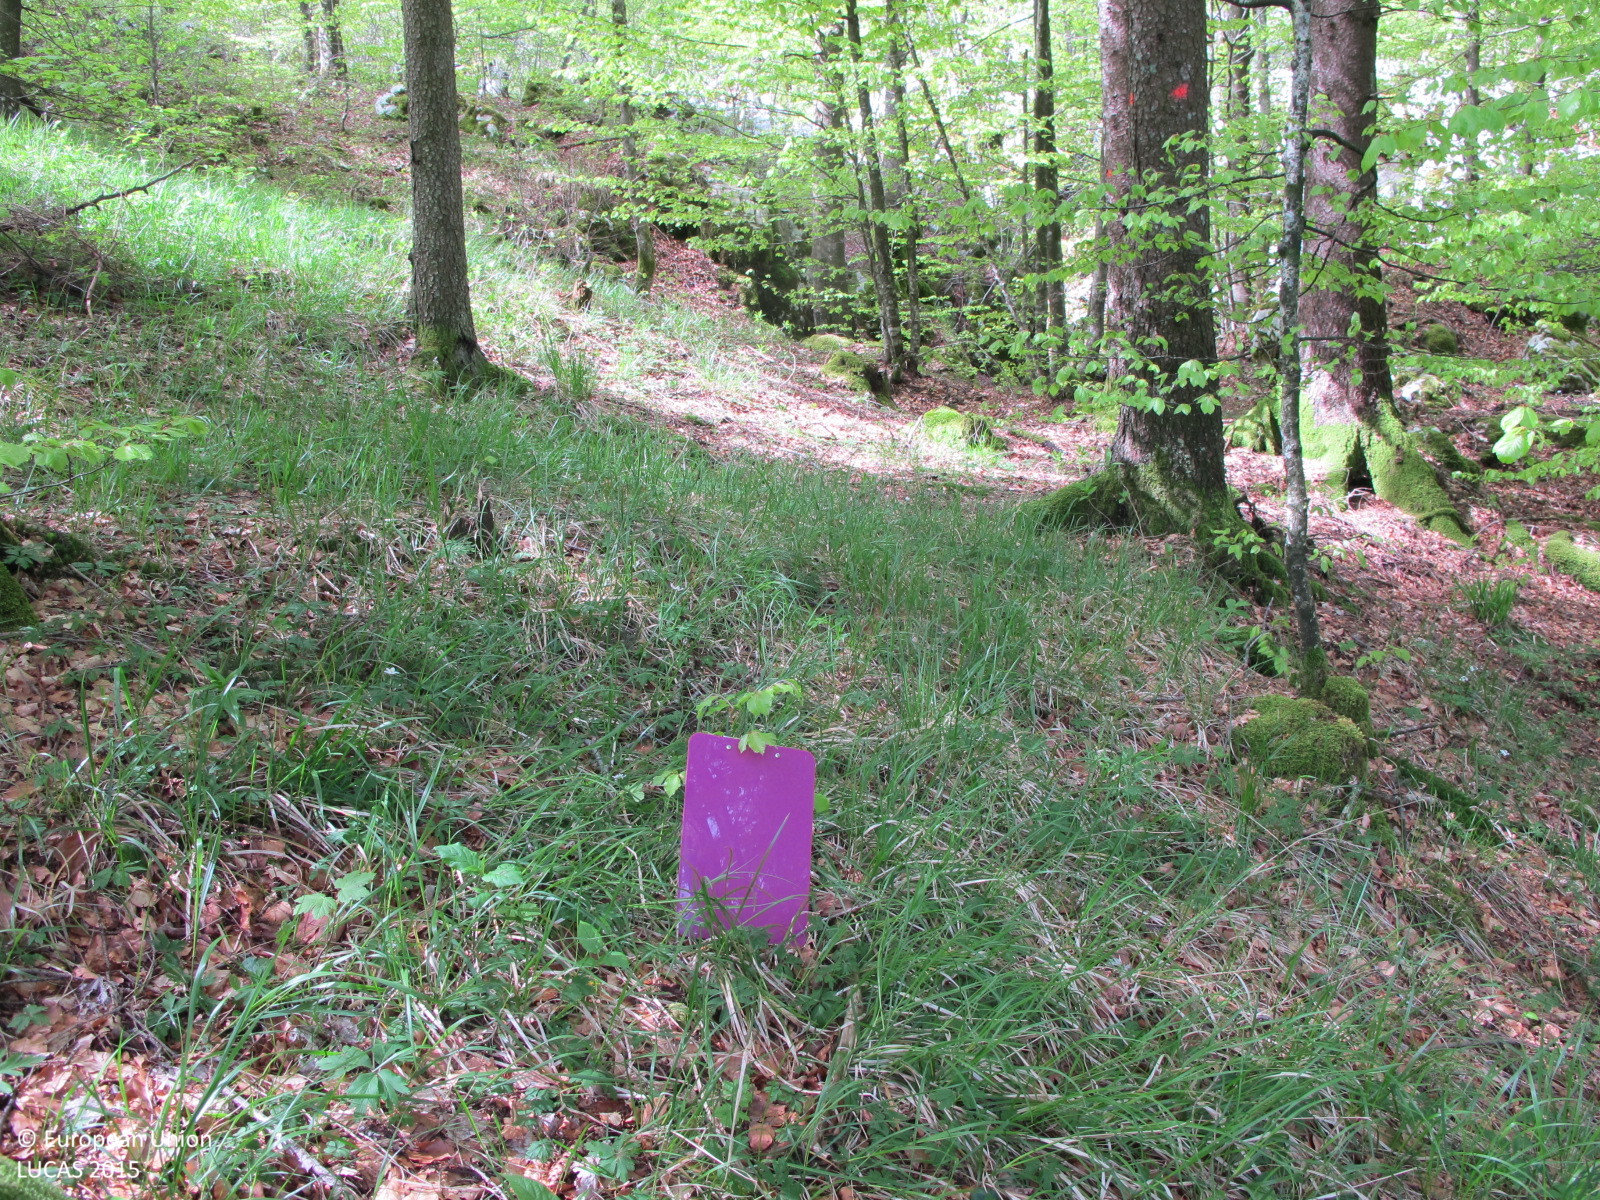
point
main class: Woodland
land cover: Broadleaved woodland
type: mountainous beech forest
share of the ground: > 75 %
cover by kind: broadleaved forest trees 90 %, coniferous forest trees 5 %, herbaceous plants 5 %
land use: Forestry
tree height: > 5 m
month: May
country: HR
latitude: 45.3469
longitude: 14.2451
